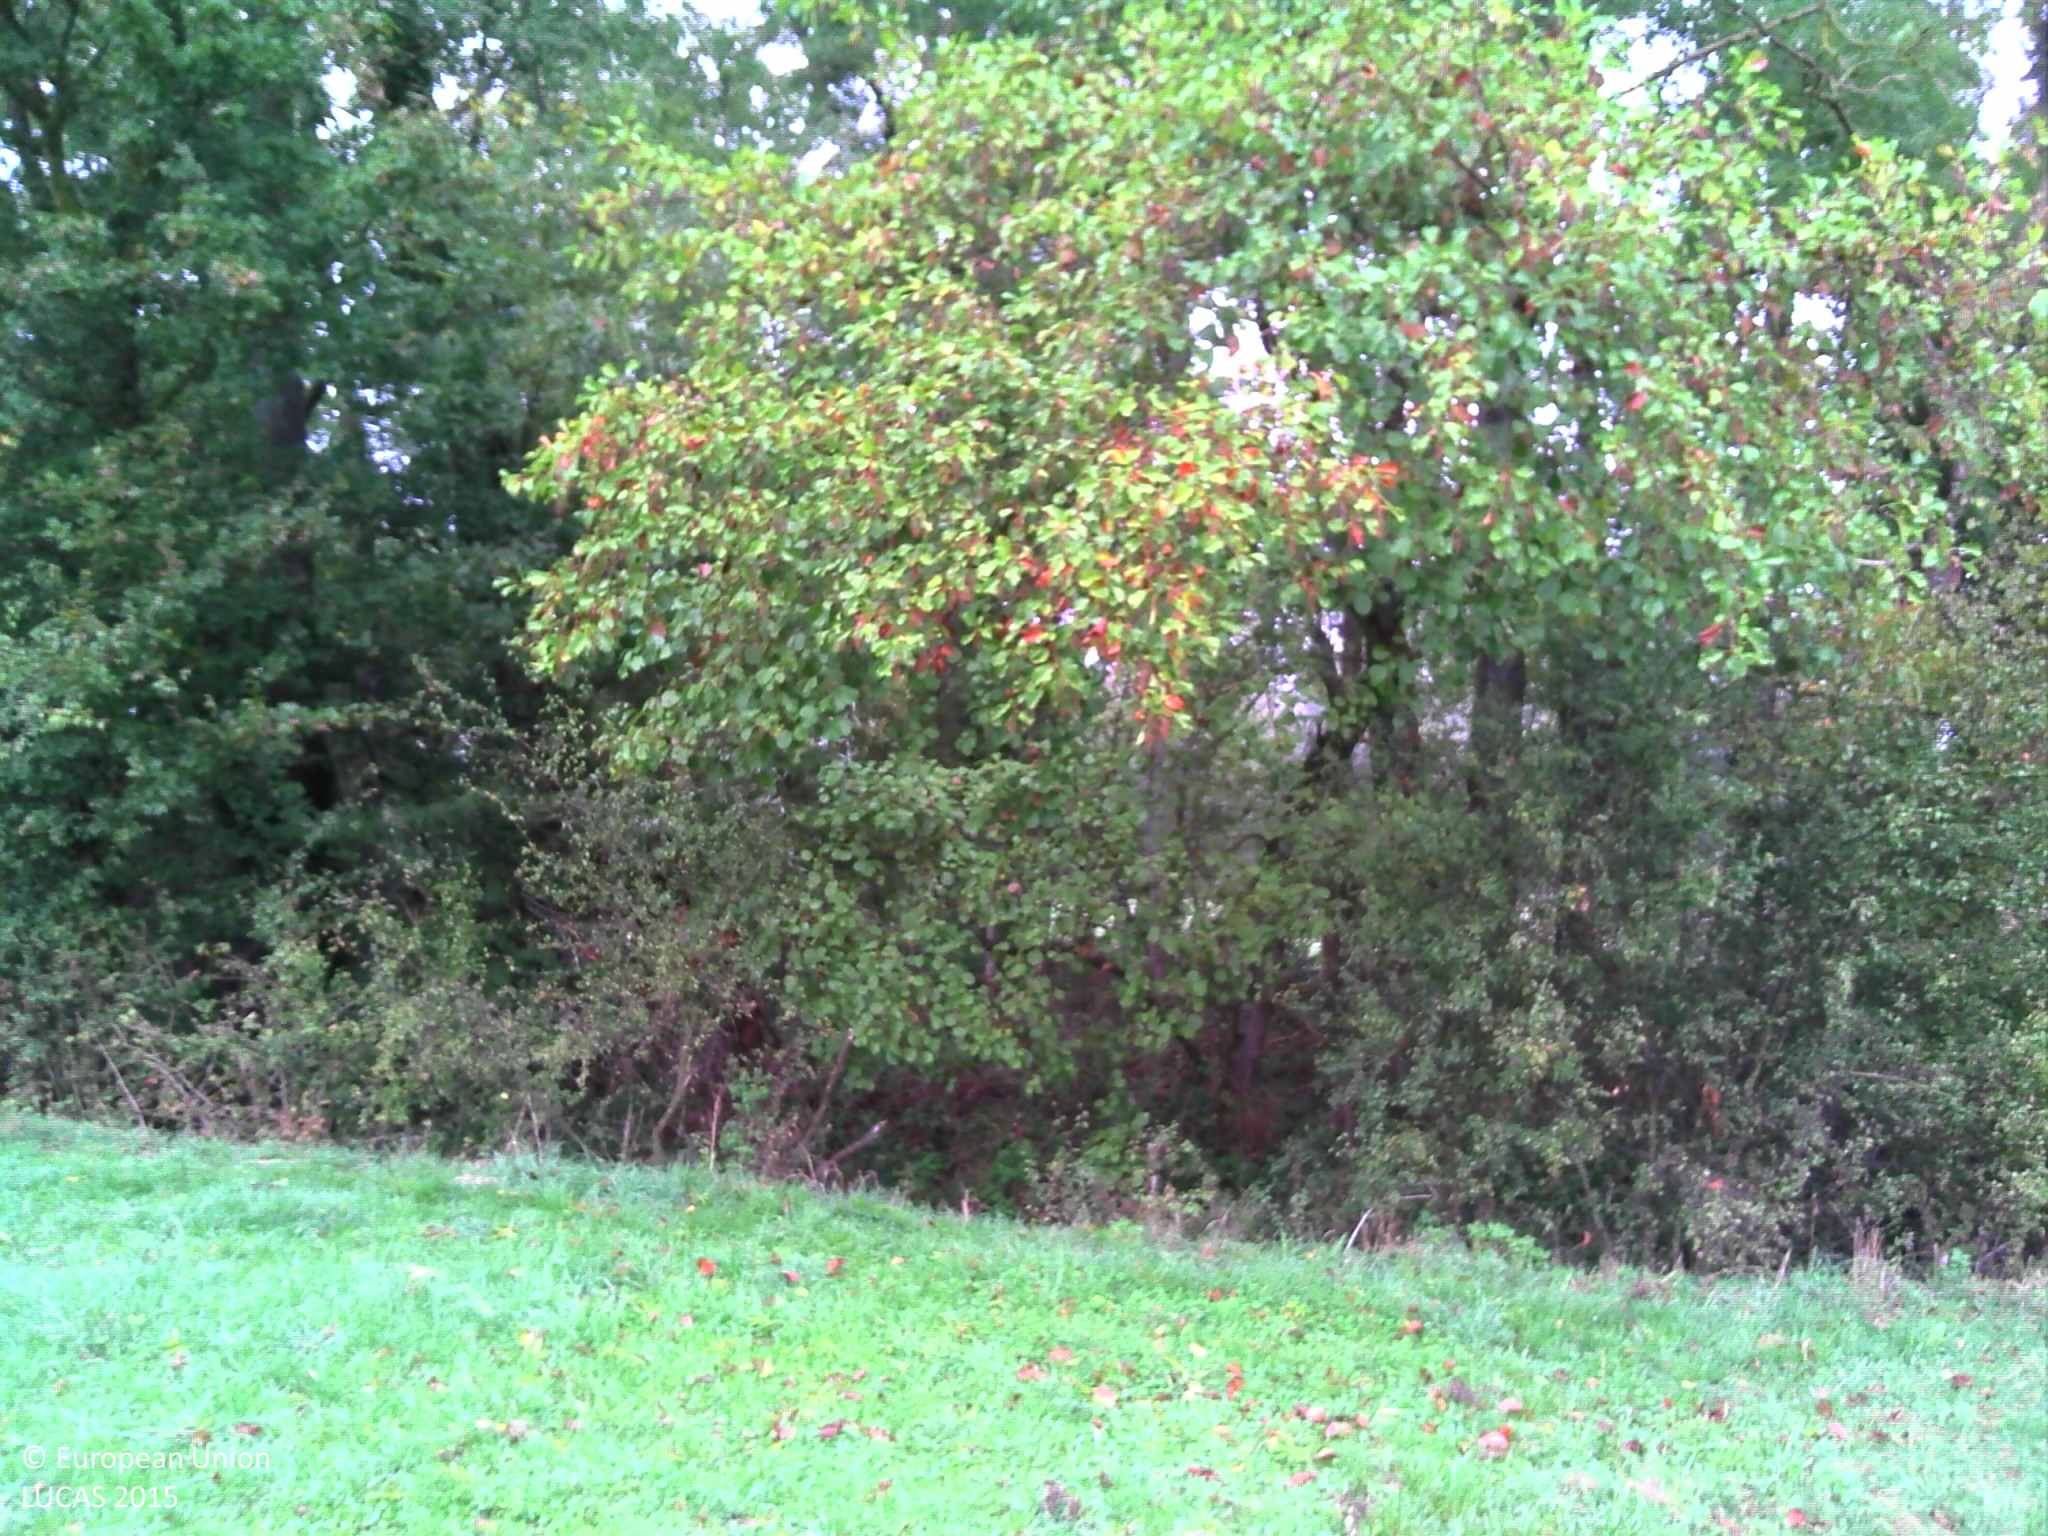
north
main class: Grassland
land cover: Grassland without tree/shrub cover
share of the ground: > 75 %
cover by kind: herbaceous plants 100 %
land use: Agriculture (excluding fallow land and kitchen gardens)
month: December
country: FR
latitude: 46.3294
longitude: 5.1055
